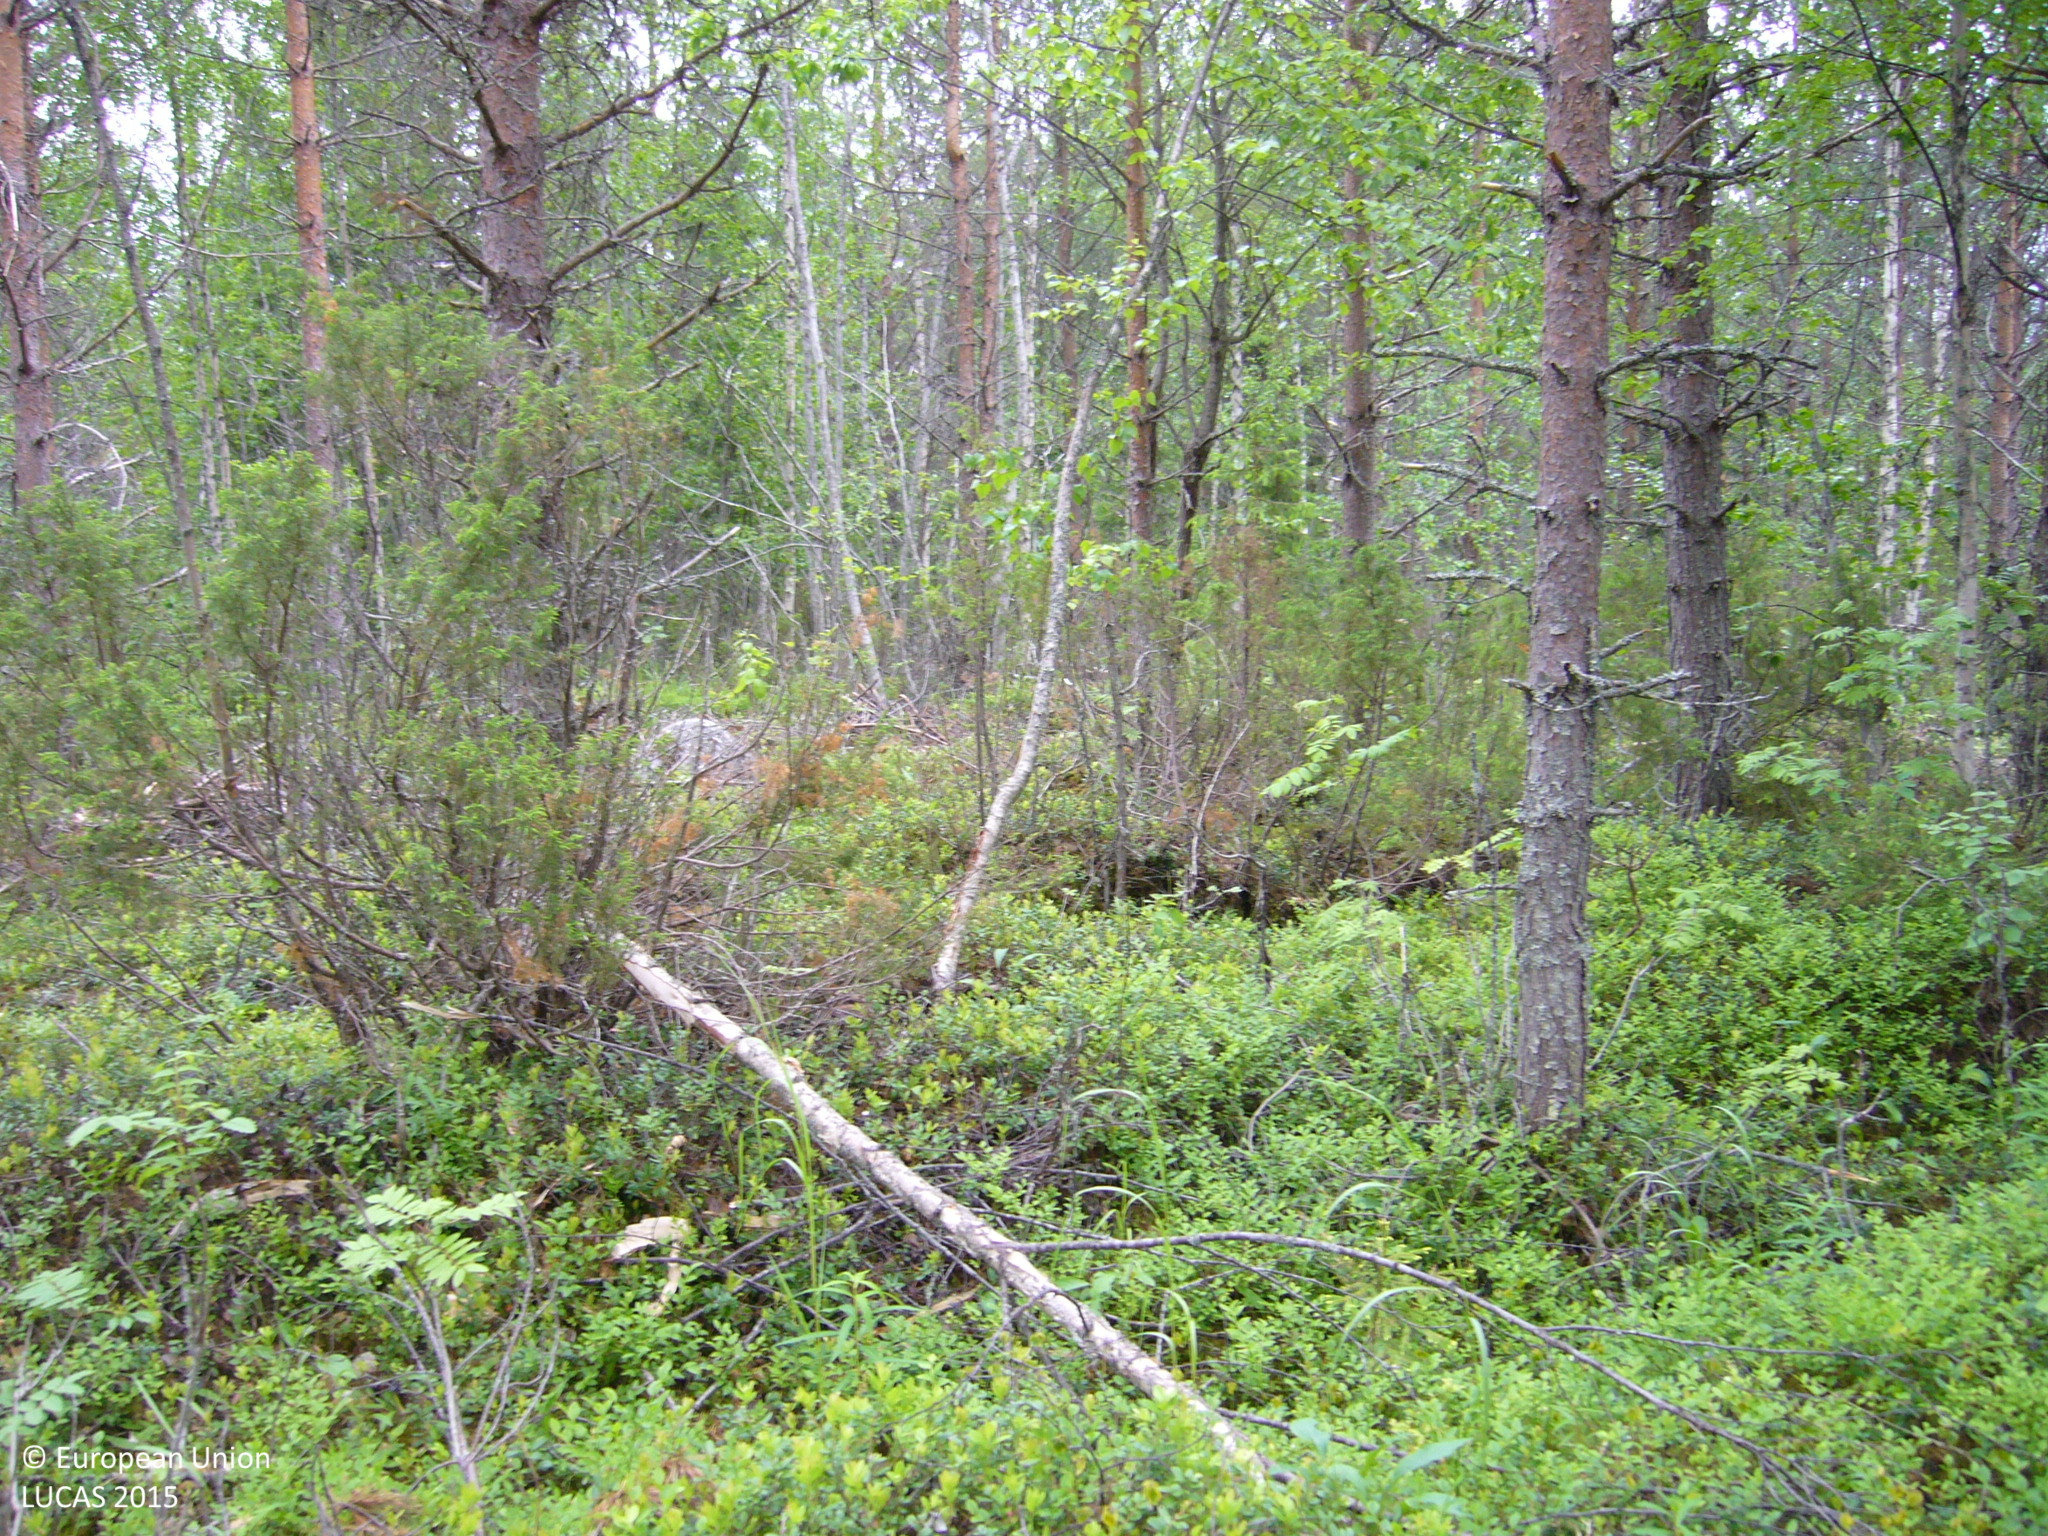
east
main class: Woodland
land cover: Pine dominated coniferous woodland
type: boreal forest
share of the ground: 50 - 75 %
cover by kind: coniferous forest trees 60 %, shrubs 35 %, broadleaved forest trees 5 %
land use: Forestry
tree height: > 5 m
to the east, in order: Pine dominated coniferous woodland; Pine dominated mixed woodland; Tracks; Rivers and streams; Other mixed woodland; Pine dominated mixed woodland; Tracks; Pine dominated mixed woodland; Spruce dominated mixed woodland
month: June
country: FI
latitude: 63.7875
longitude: 26.1237
